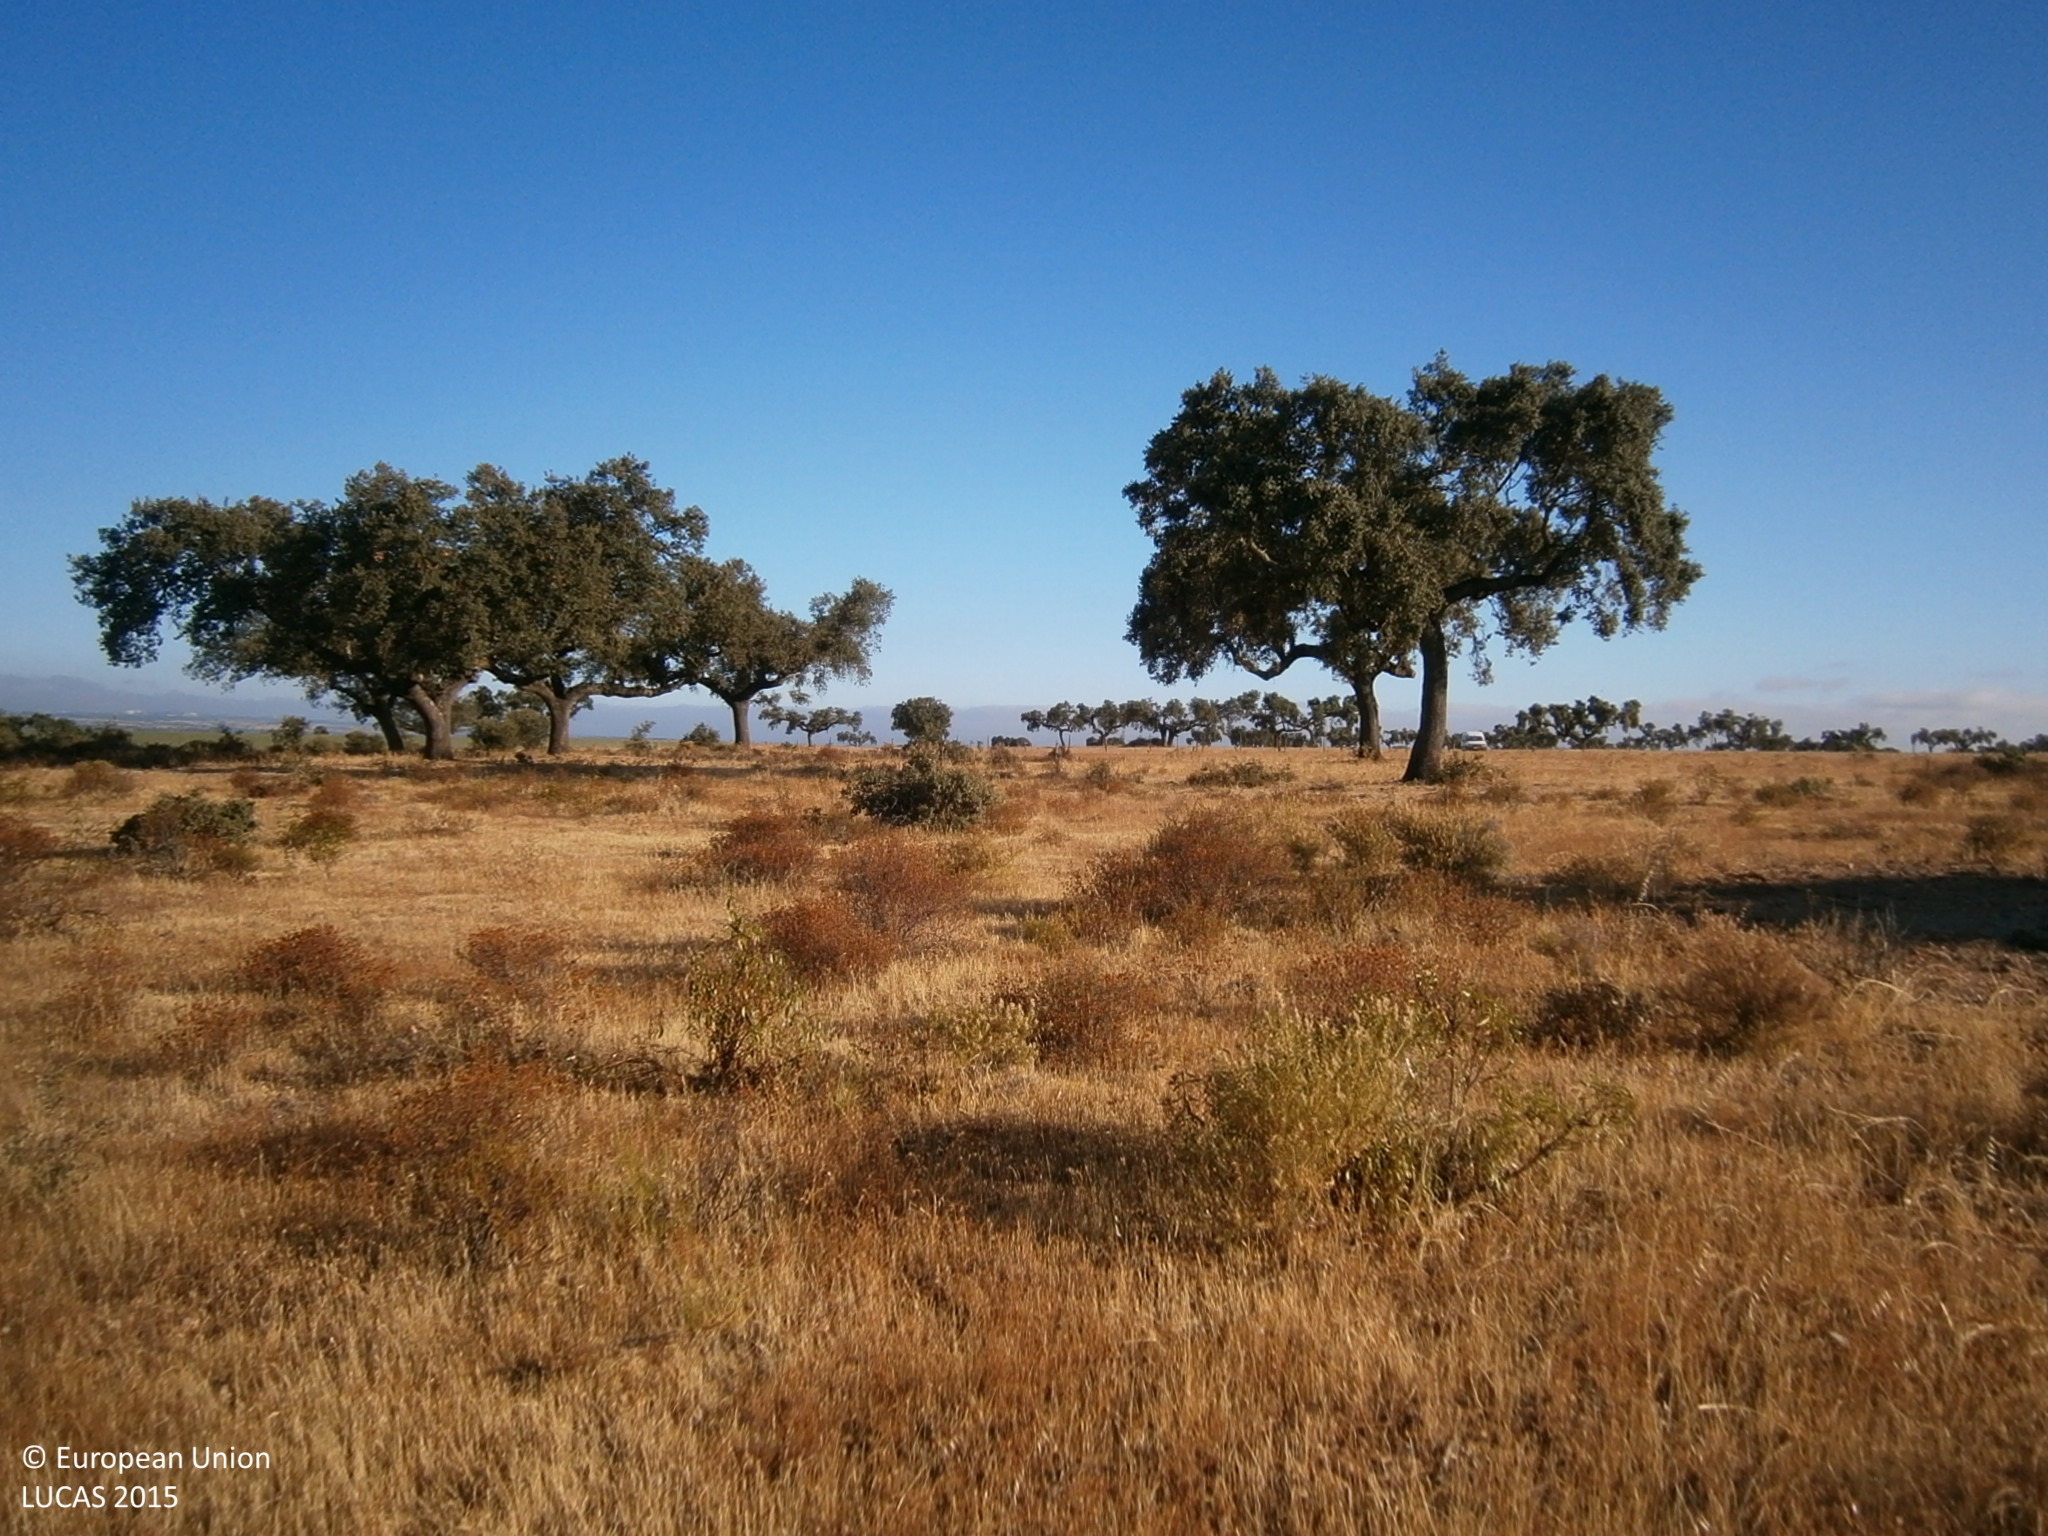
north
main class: Woodland
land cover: Broadleaved woodland
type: broadleaved evergreen forest
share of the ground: > 75 %
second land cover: Shrubland without tree cover
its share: < 10 %
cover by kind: broadleaved forest trees 70 %, herbaceous plants 20 %, shrubs 10 %
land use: Agriculture (excluding fallow land and kitchen gardens)
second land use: Forestry
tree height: > 5 m
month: July
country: ES
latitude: 38.6565
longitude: -7.2278
